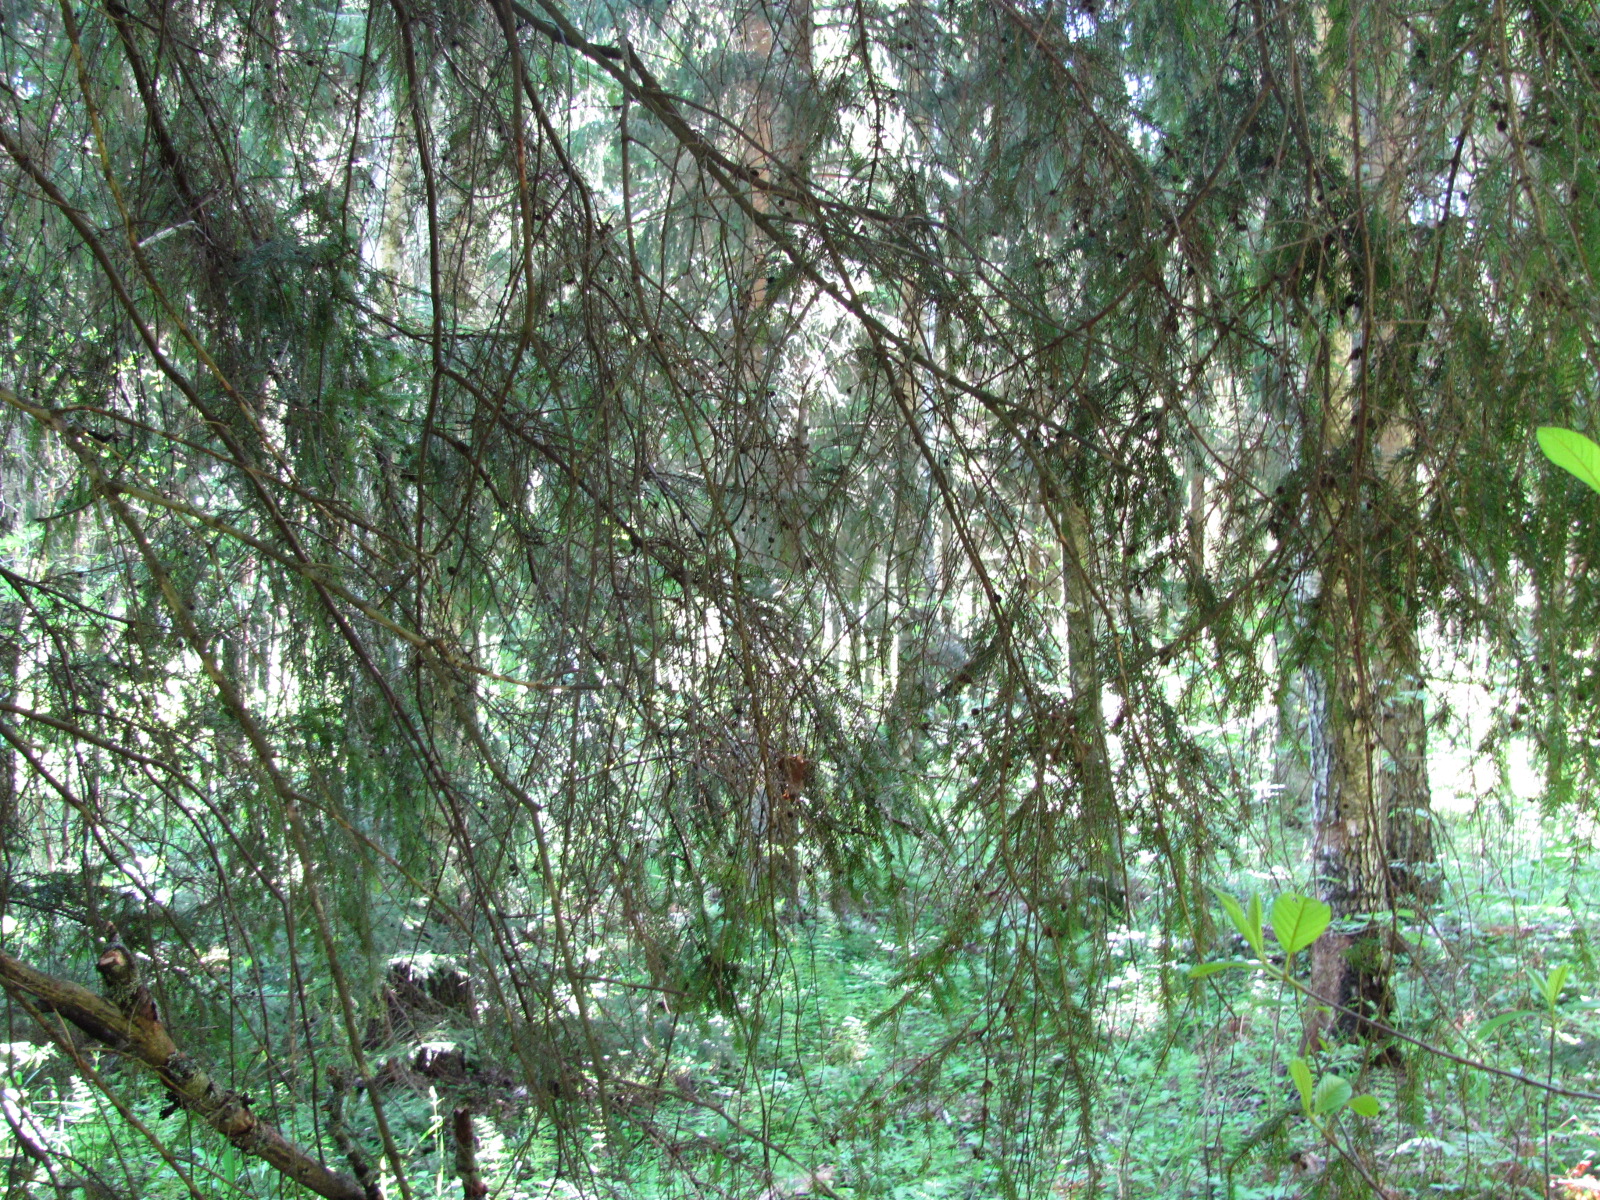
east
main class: Woodland
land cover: Other coniferous woodland
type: hemiboreal forest and nemoral coniferous forest and mixed broadleaved-coniferous forest
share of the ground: > 75 %
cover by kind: coniferous forest trees 95 %, broadleaved forest trees 5 %
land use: Forestry
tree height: > 5 m
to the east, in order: Other coniferous woodland; Spruce dominated coniferous woodland; Electric lines; Spontaneously vegetated surfaces; Grassland with sparse tree/shrub cover; Inland fresh running water; Grassland without tree/shrub cover; Artificial constructions in urban areas; Other coniferous woodland
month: May
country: LV
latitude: 56.6830
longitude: 24.1090
